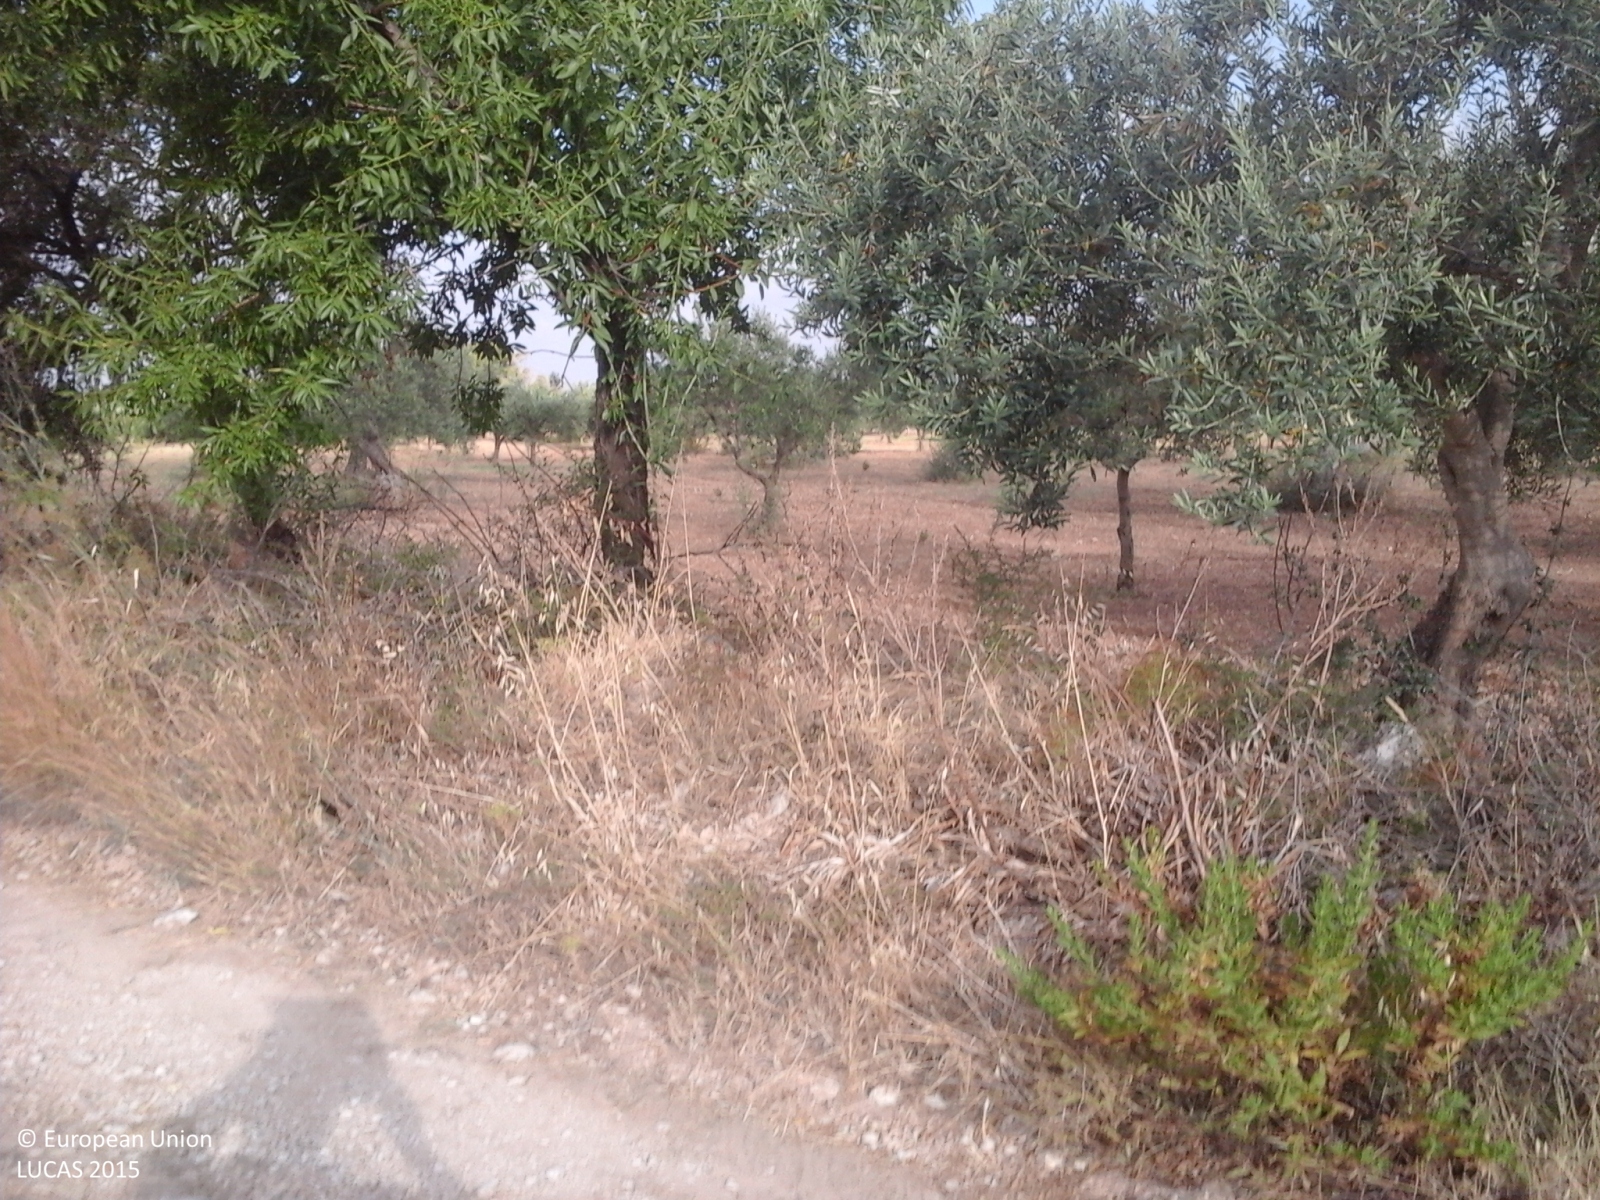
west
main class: Cropland
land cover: Olive groves
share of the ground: > 75 %
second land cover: Spontaneously vegetated surfaces
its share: > 75 %
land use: Agriculture (excluding fallow land and kitchen gardens)
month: July
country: IT
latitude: 37.0154
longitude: 14.6502
